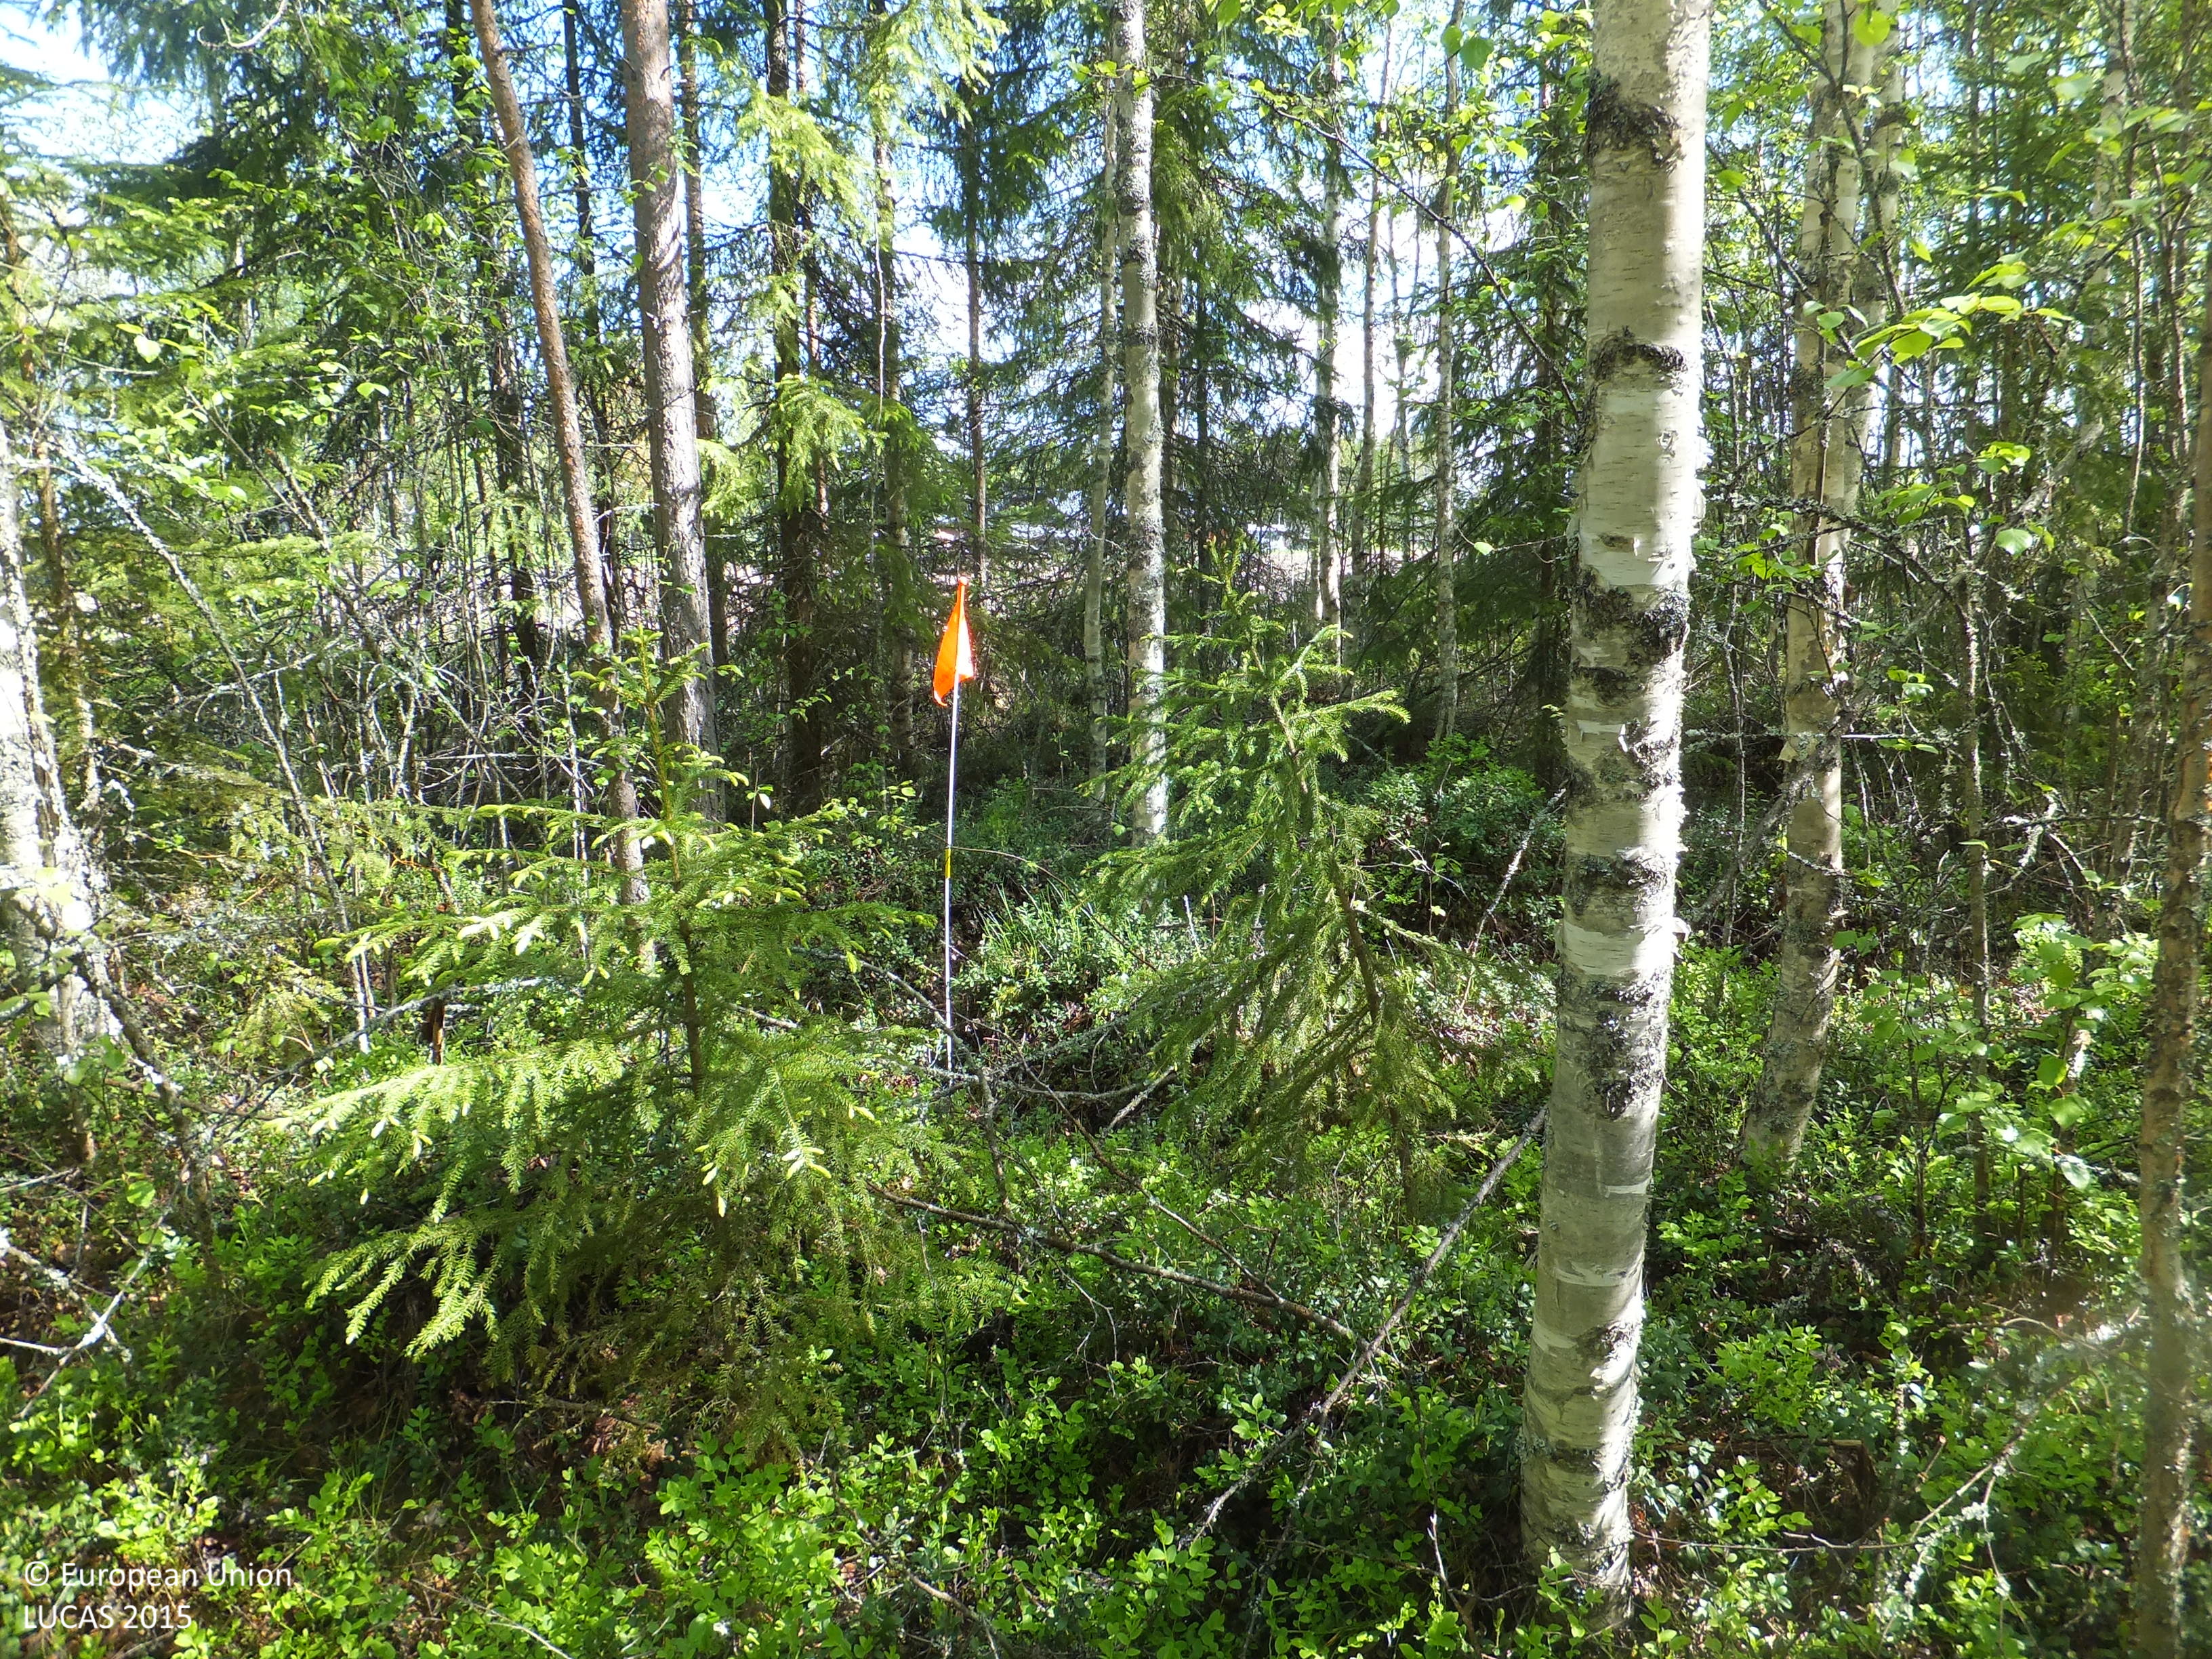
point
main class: Woodland
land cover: Spruce dominated mixed woodland
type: boreal forest
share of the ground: > 75 %
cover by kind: broadleaved forest trees 60 %, coniferous forest trees 30 %, shrubs 10 %
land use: Forestry
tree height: > 5 m
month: June
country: FI
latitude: 63.5915
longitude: 22.9296
